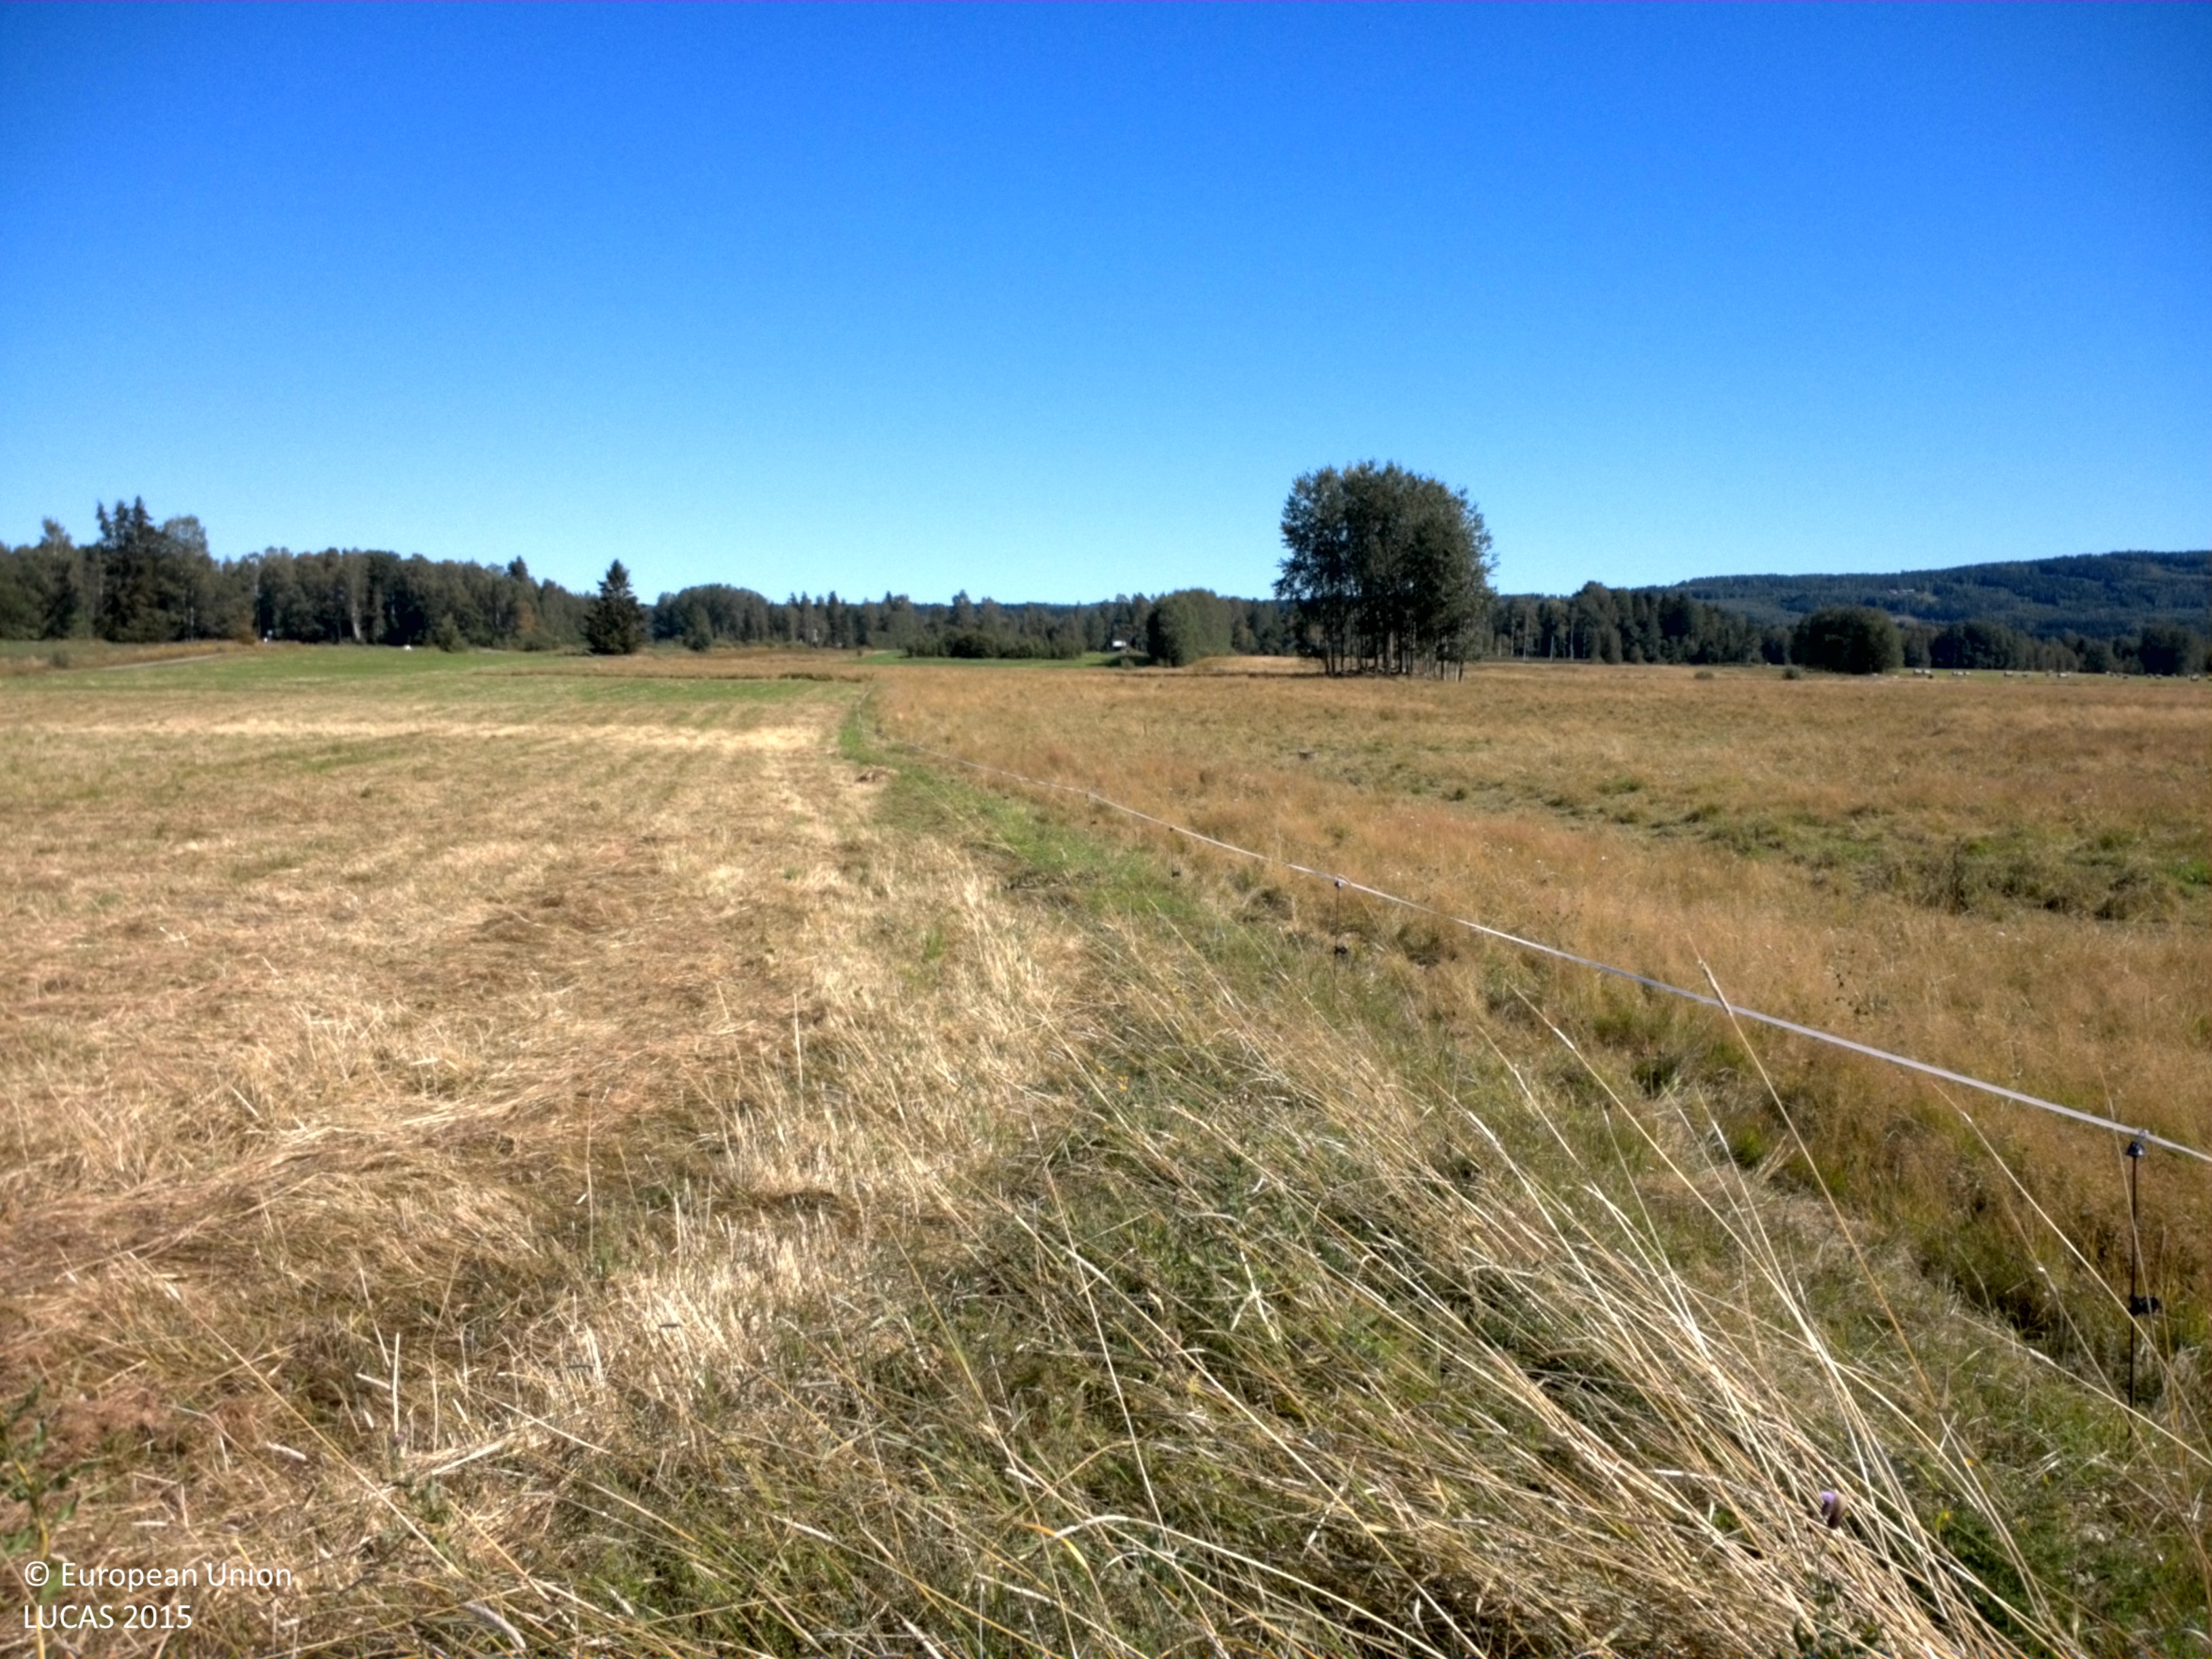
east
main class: Grassland
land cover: Grassland without tree/shrub cover
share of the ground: > 75 %
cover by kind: herbaceous plants 95 %, consolidated bare surface 5 %
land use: Agriculture (excluding fallow land and kitchen gardens)
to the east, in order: Grassland without tree/shrub cover; Ditches and canals; Grassland without tree/shrub cover
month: August
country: SE
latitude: 59.8744
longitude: 13.1890
